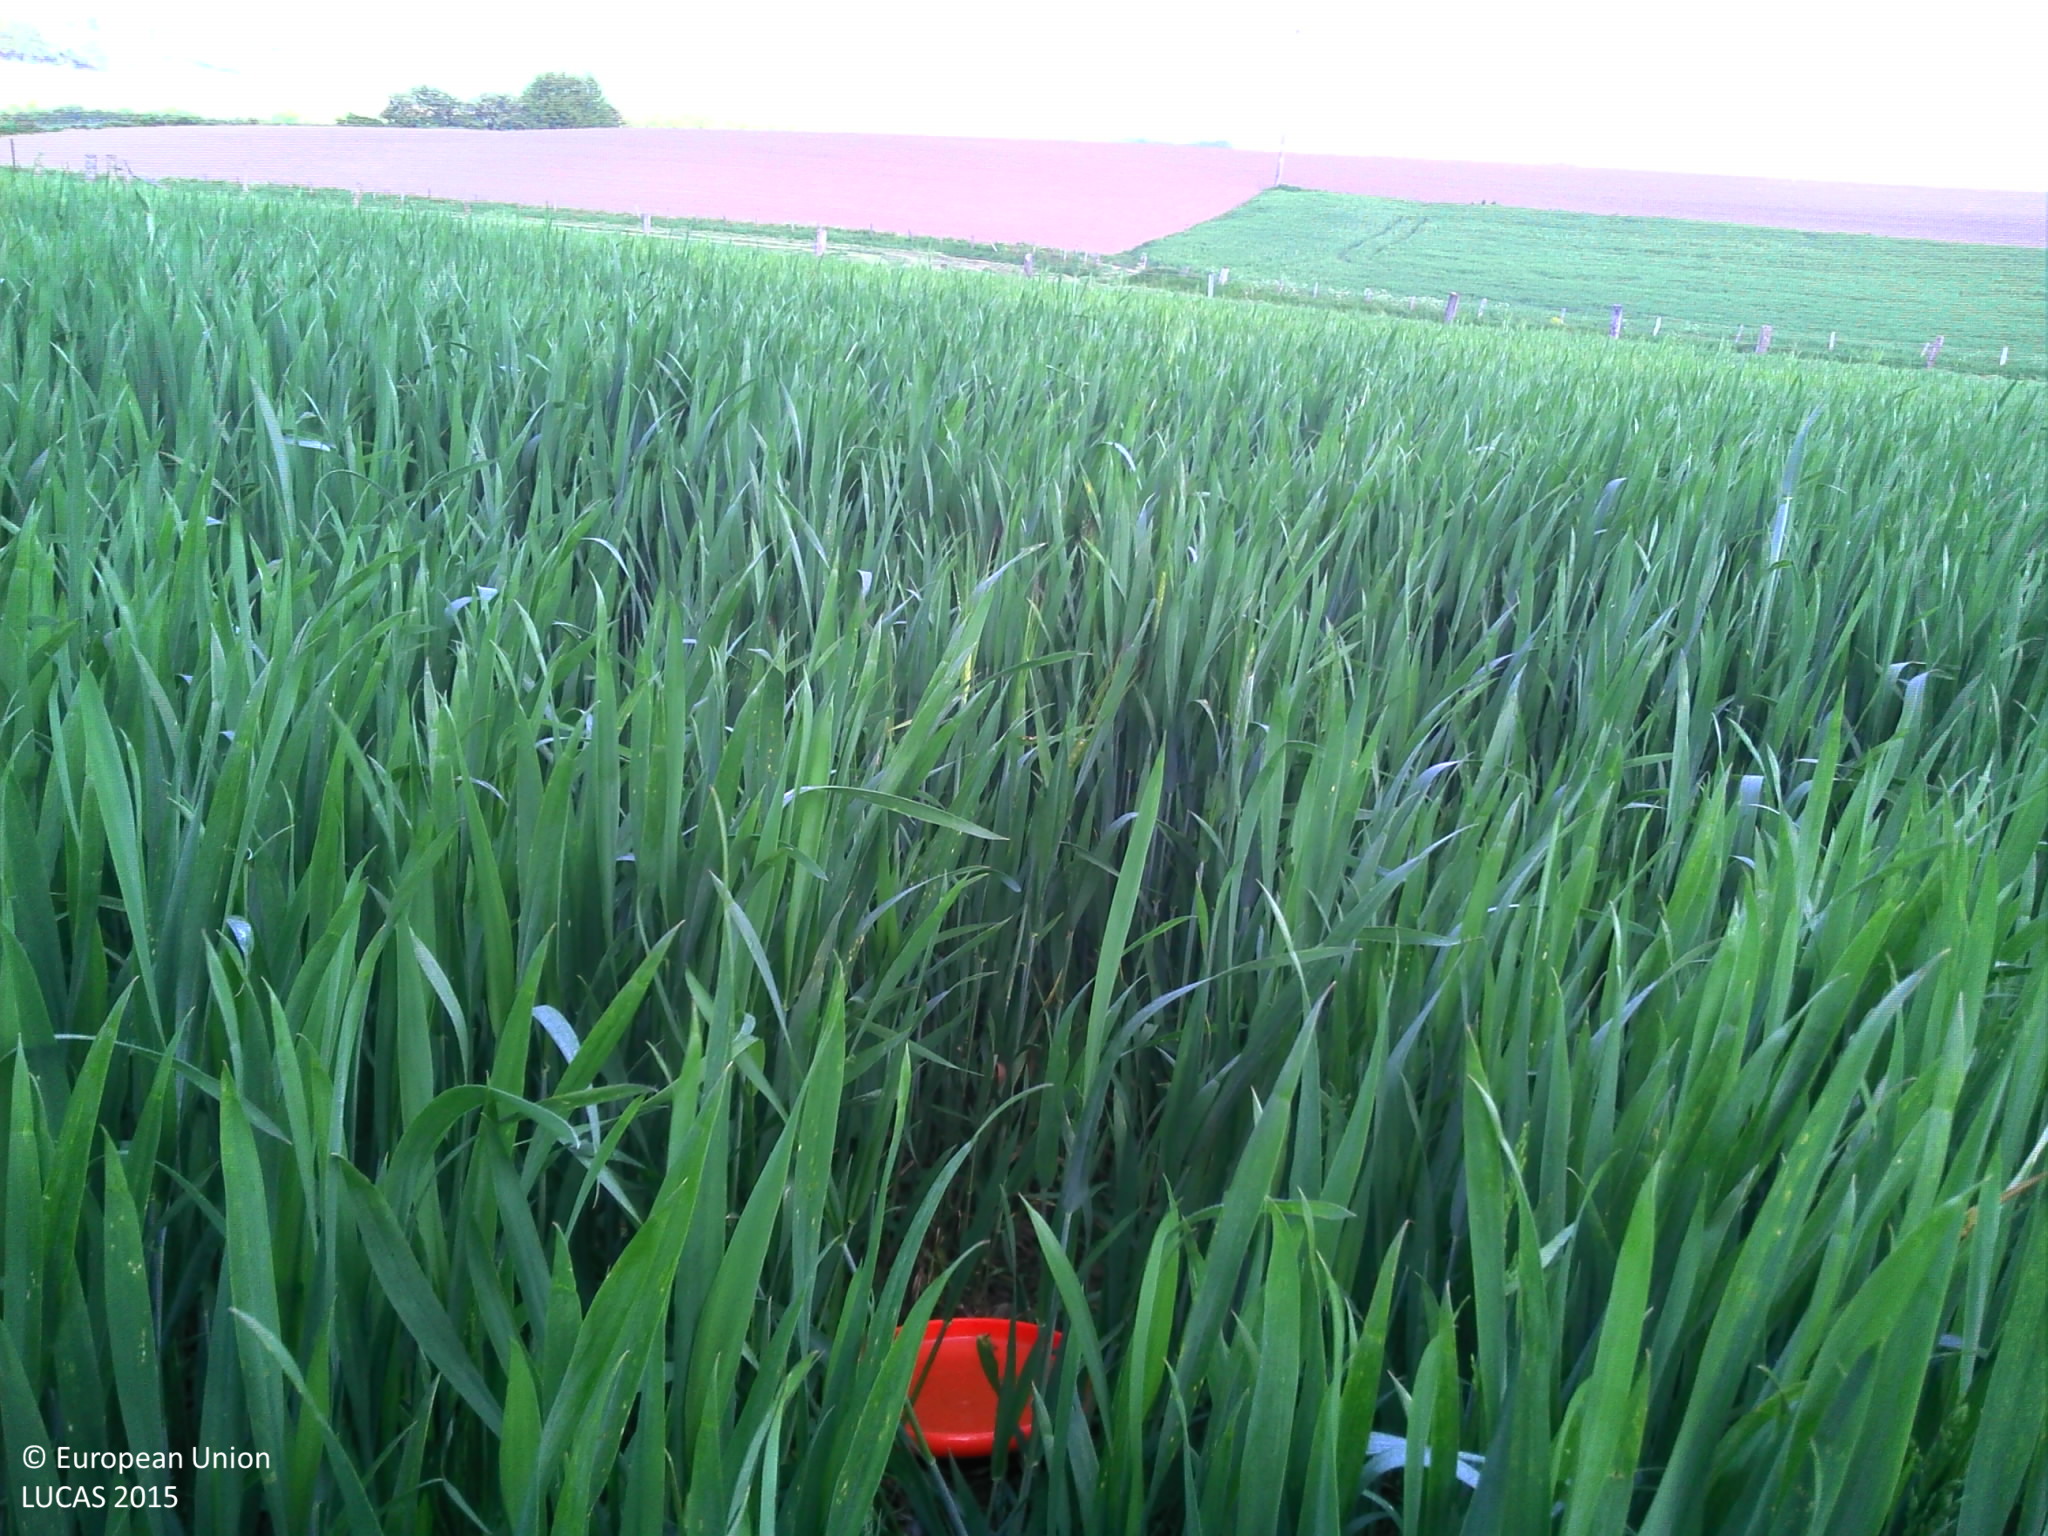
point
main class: Cropland
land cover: Common wheat
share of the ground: > 75 %
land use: Agriculture (excluding fallow land and kitchen gardens)
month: May
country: LU
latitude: 50.1325
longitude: 6.0120
